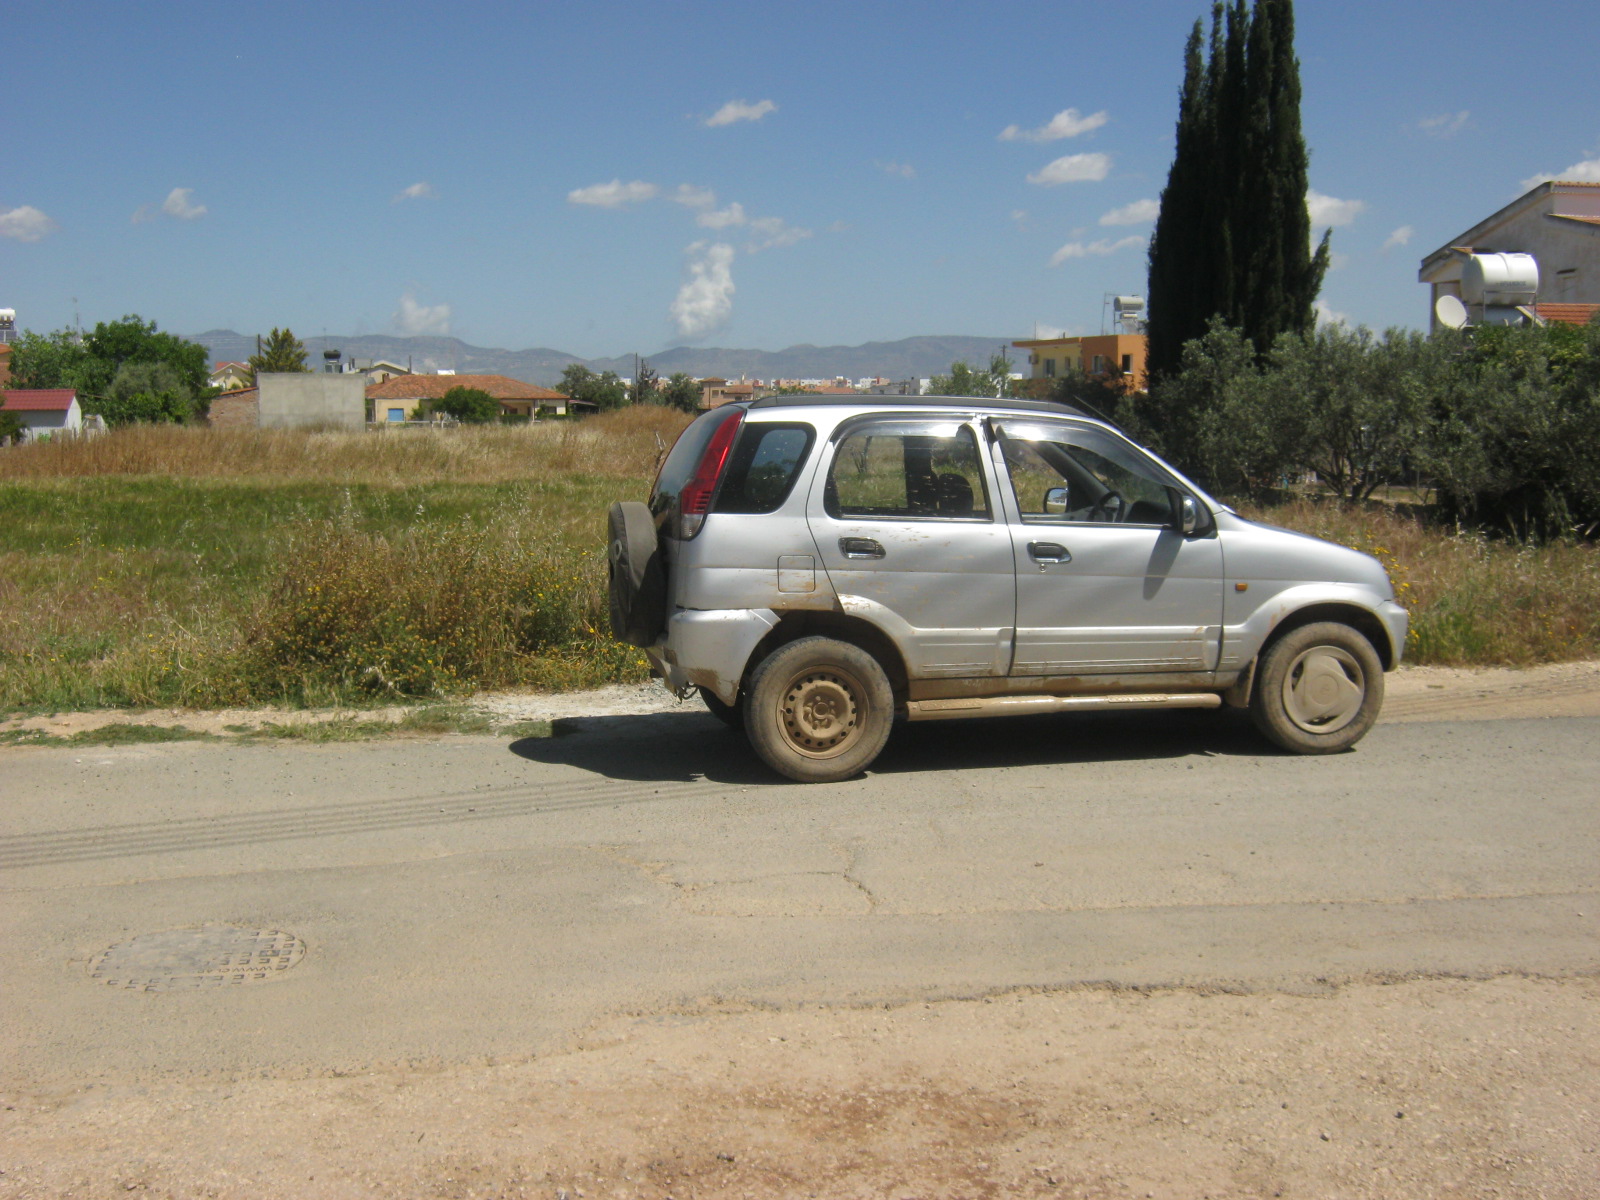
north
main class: Artificial land
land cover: Non built-up linear features
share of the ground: > 75 %
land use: Road transport
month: May
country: CY
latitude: 35.1536
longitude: 33.2066
